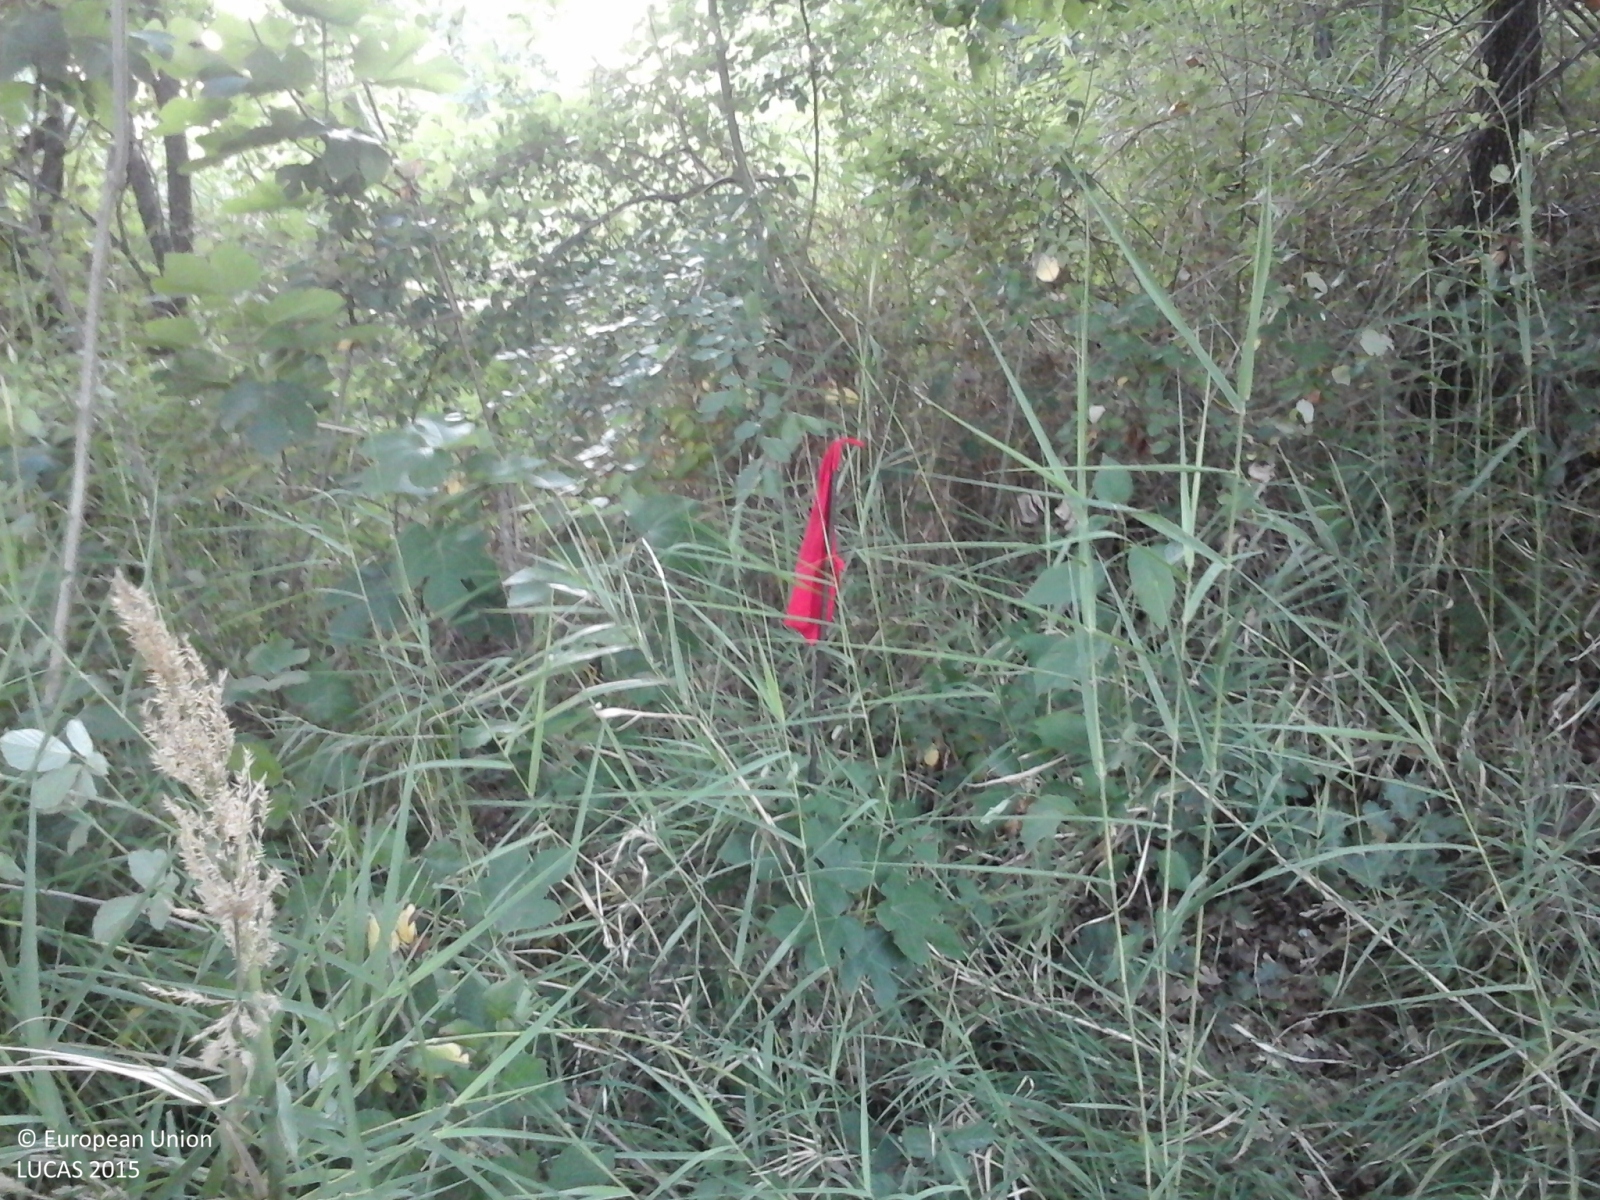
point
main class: Woodland
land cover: Broadleaved woodland
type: thermophilous deciduous forest
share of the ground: > 75 %
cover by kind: broadleaved forest trees 80 %, shrubs 10 %, herbaceous plants 10 %
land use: Semi-natural and natural areas not in use
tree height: > 5 m
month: June
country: IT
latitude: 42.0743
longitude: 14.3013
